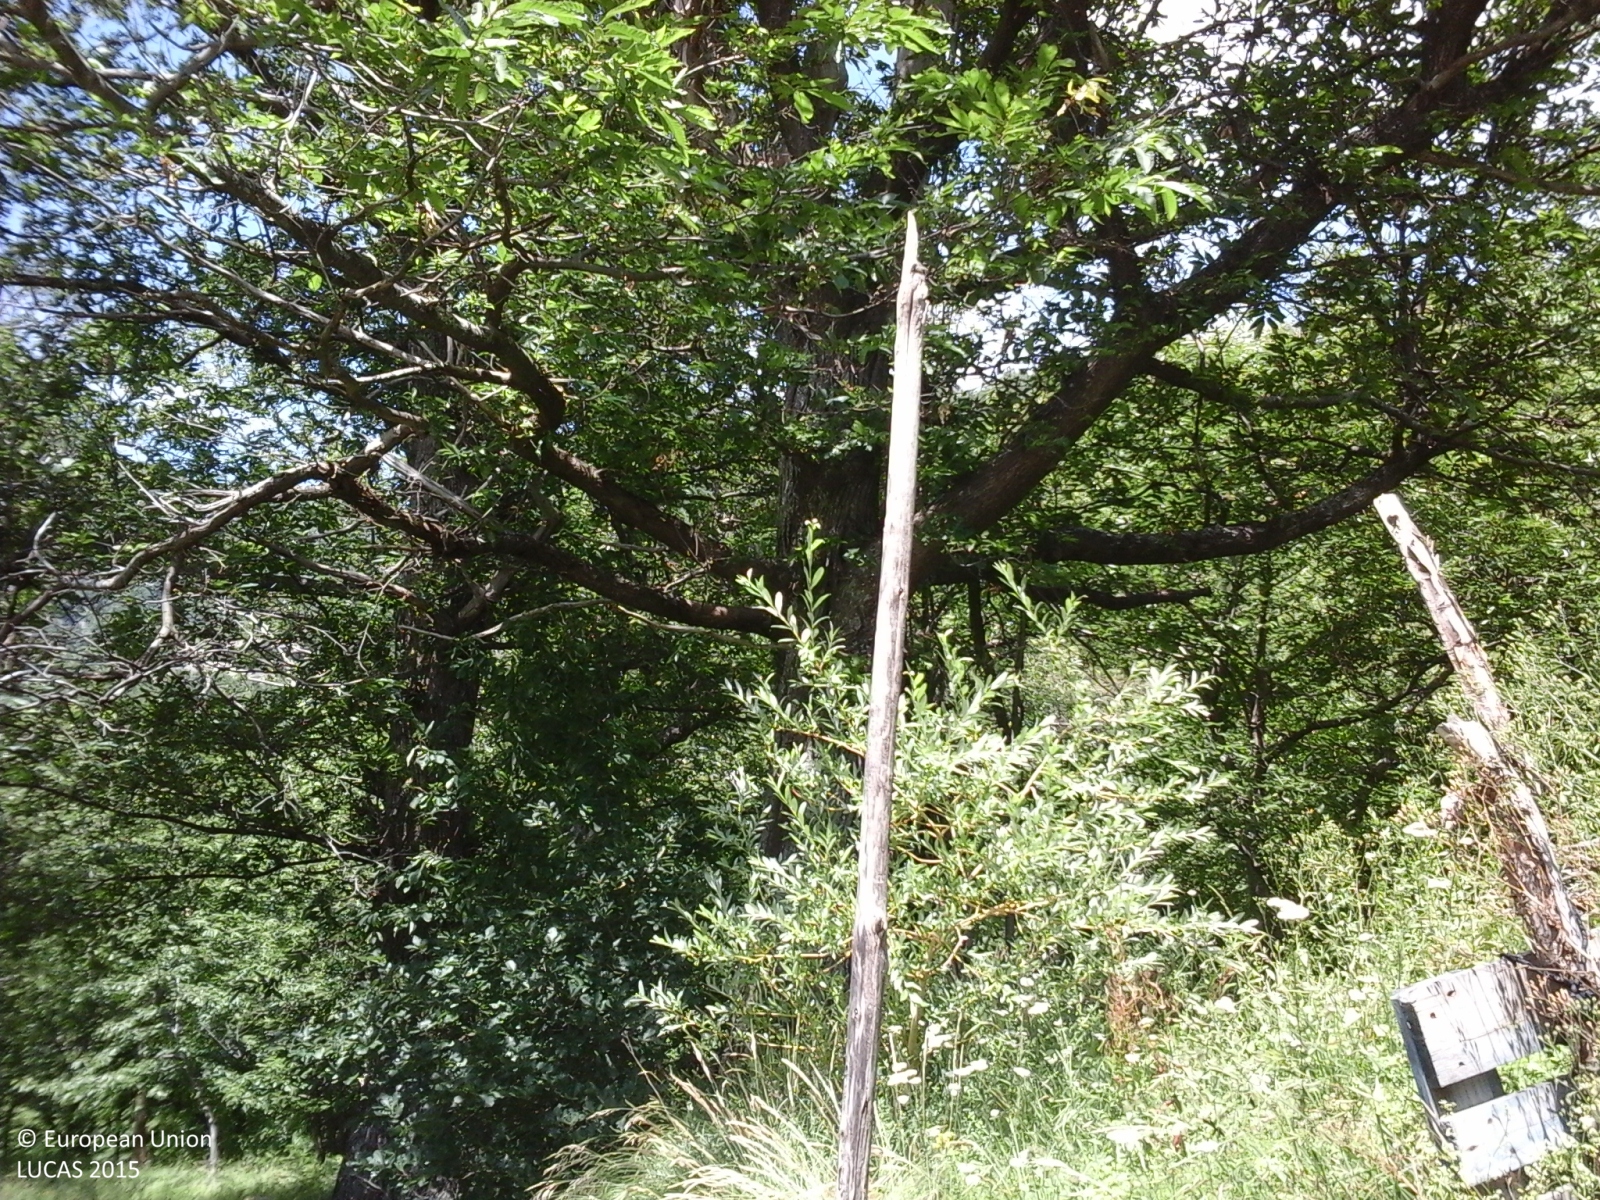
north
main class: Grassland
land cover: Spontaneously vegetated surfaces
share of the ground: > 75 %
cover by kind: herbaceous plants 100 %
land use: Semi-natural and natural areas not in use
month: June
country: IT
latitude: 42.8146
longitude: 13.3779
